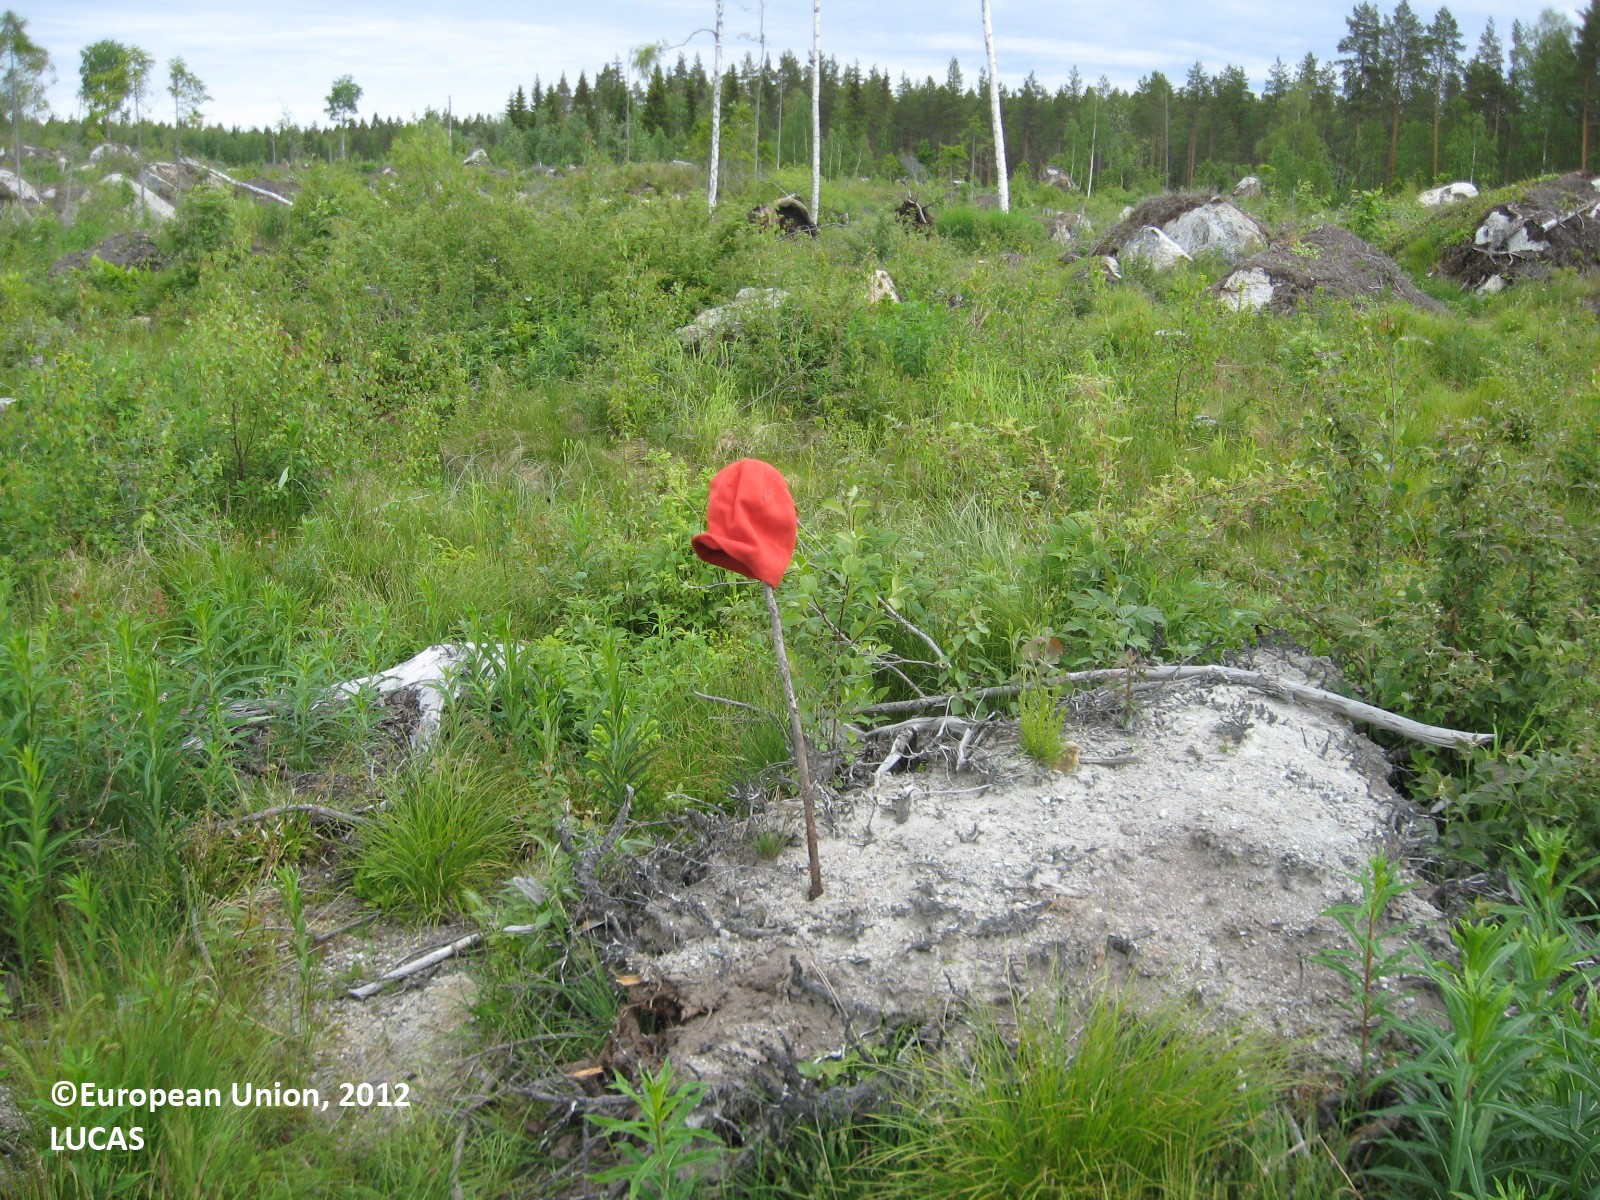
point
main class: Grassland
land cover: Grassland with sparse tree/shrub cover
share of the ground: > 75 %
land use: Forestry
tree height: < 5 m
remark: Clear cut
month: June
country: FI
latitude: 63.1033
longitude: 21.9518
